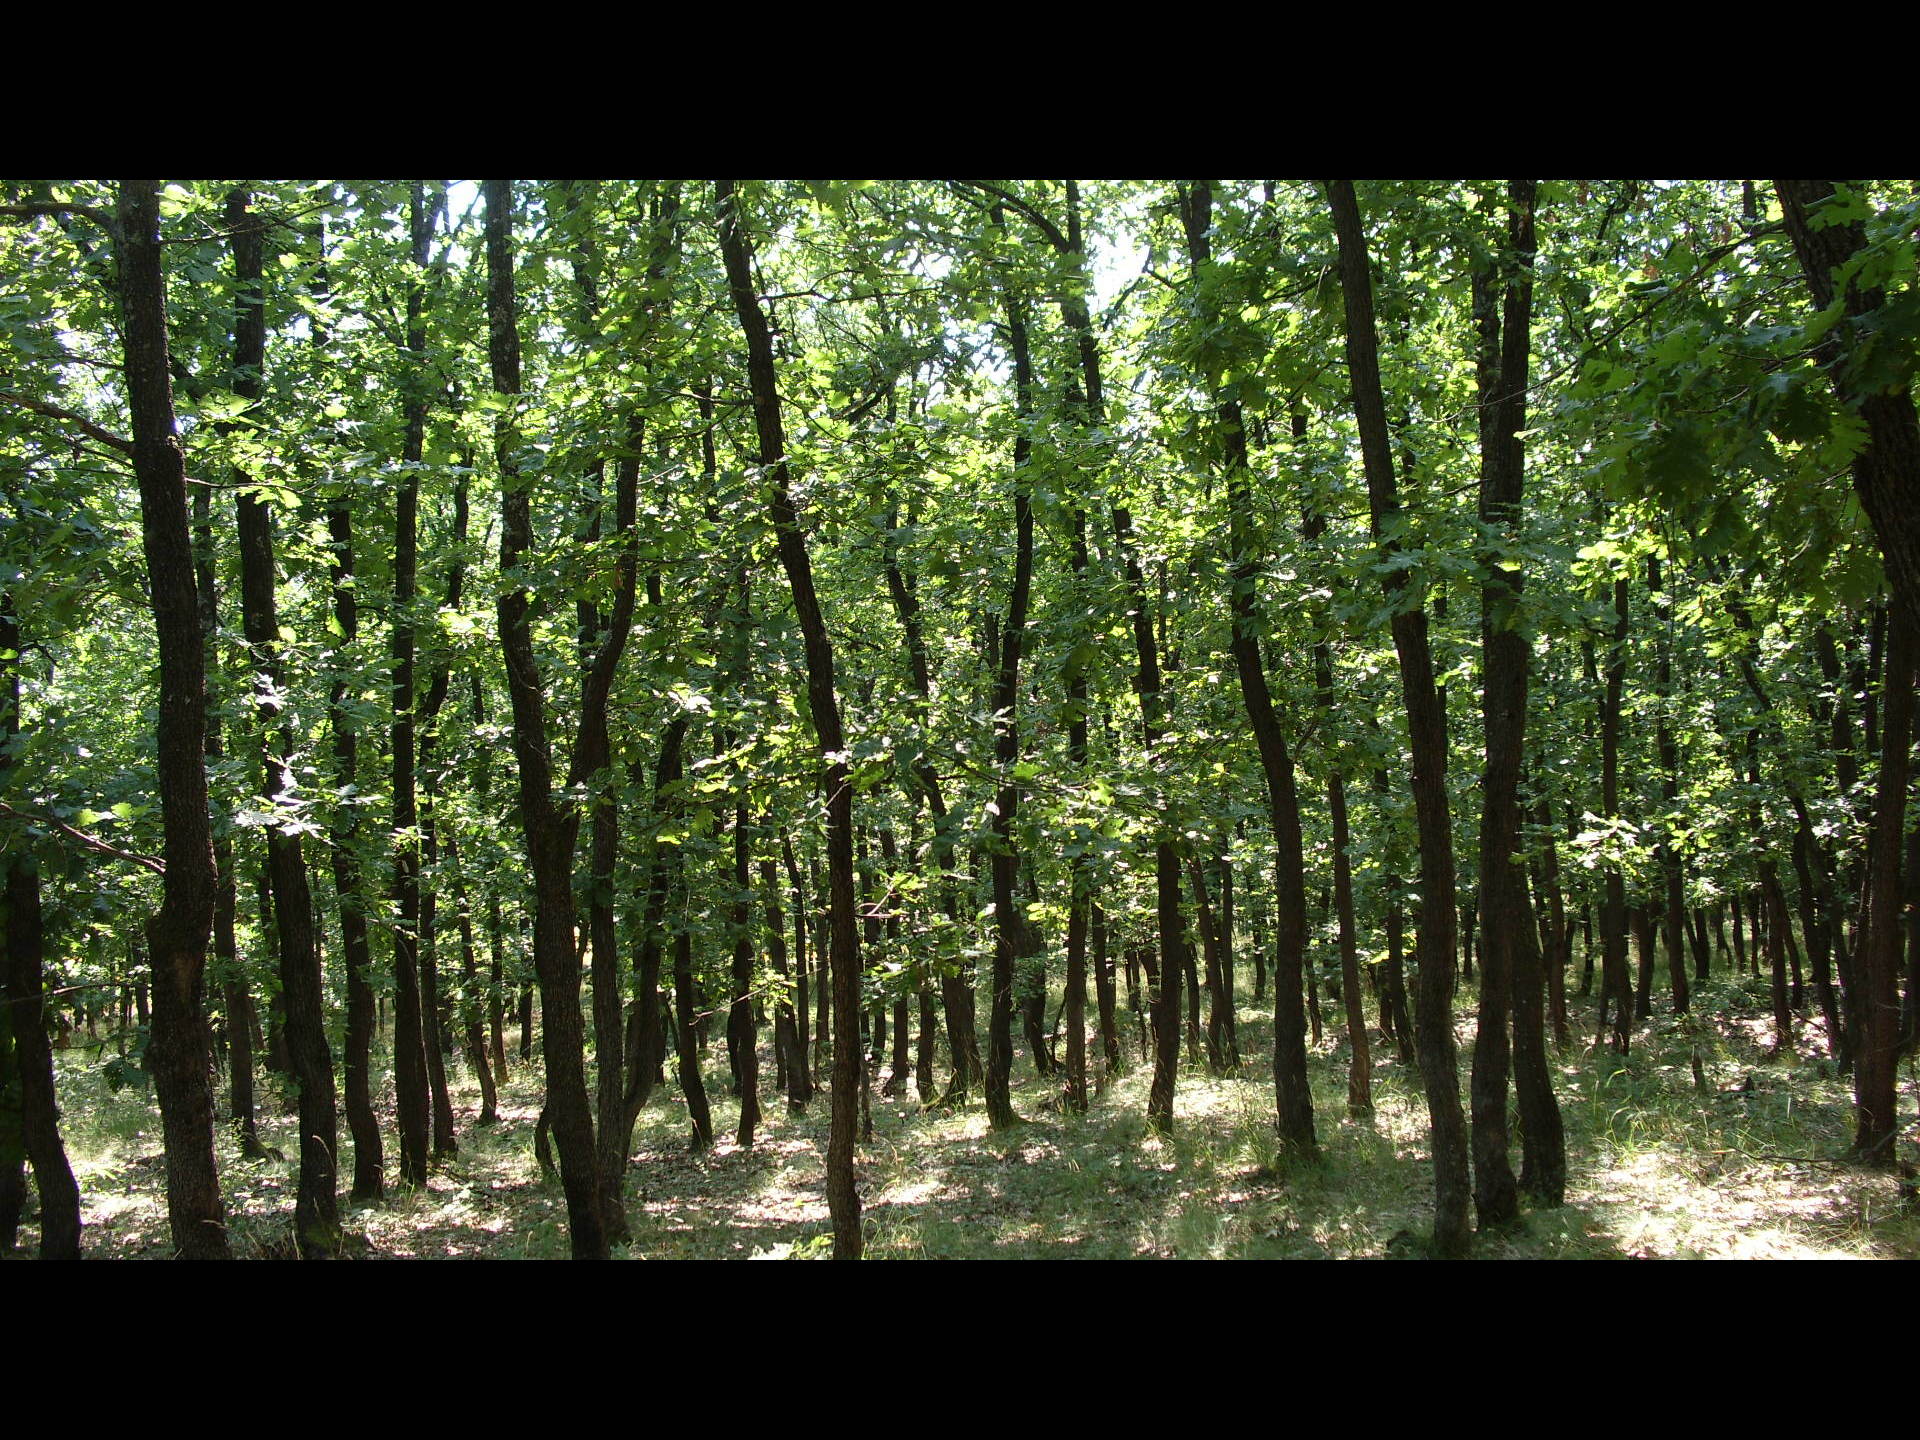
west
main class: Woodland
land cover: Broadleaved woodland
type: mesophytic deciduous forest
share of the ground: > 75 %
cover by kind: broadleaved forest trees 80 %, shrubs 10 %, herbaceous plants 10 %
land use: Forestry
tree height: > 5 m
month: July
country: BG
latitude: 43.7685
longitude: 22.5428
